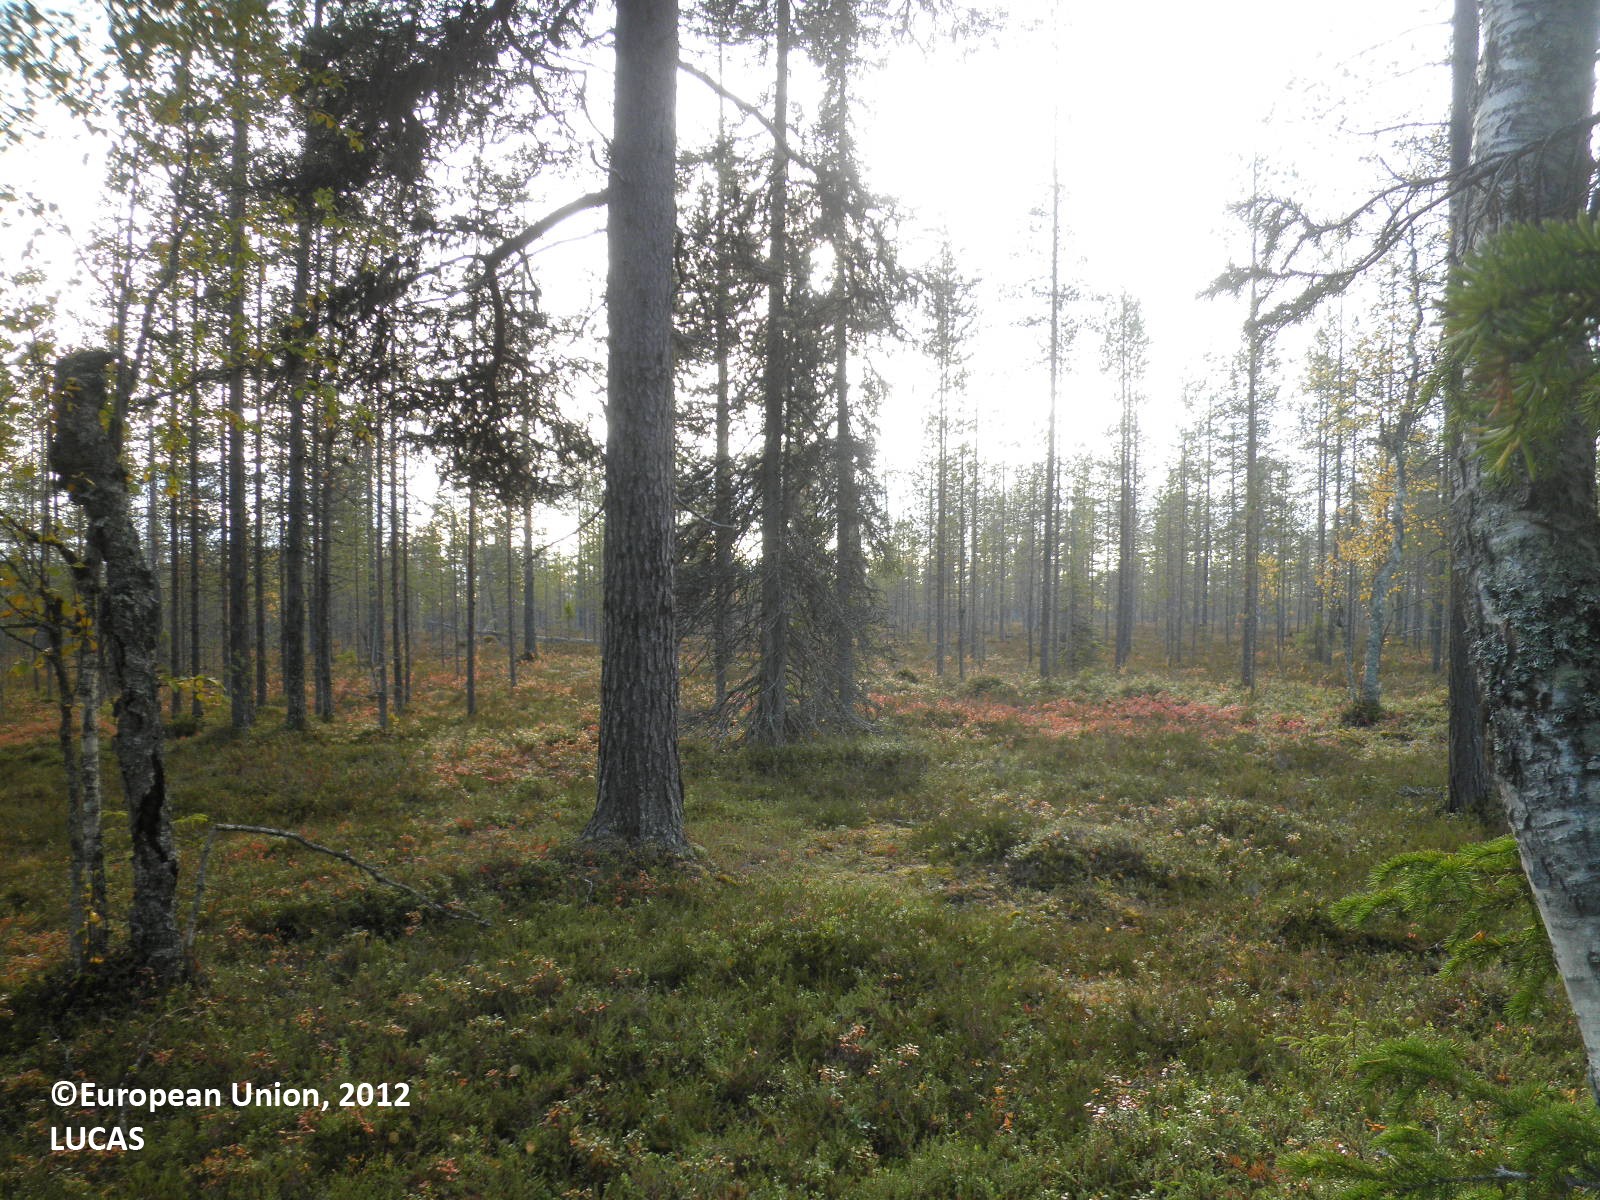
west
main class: Woodland
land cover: Spruce dominated mixed woodland
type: boreal forest
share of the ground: 25 - 50 %
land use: Forestry
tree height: > 5 m
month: September
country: FI
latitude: 67.7646
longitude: 28.7202
